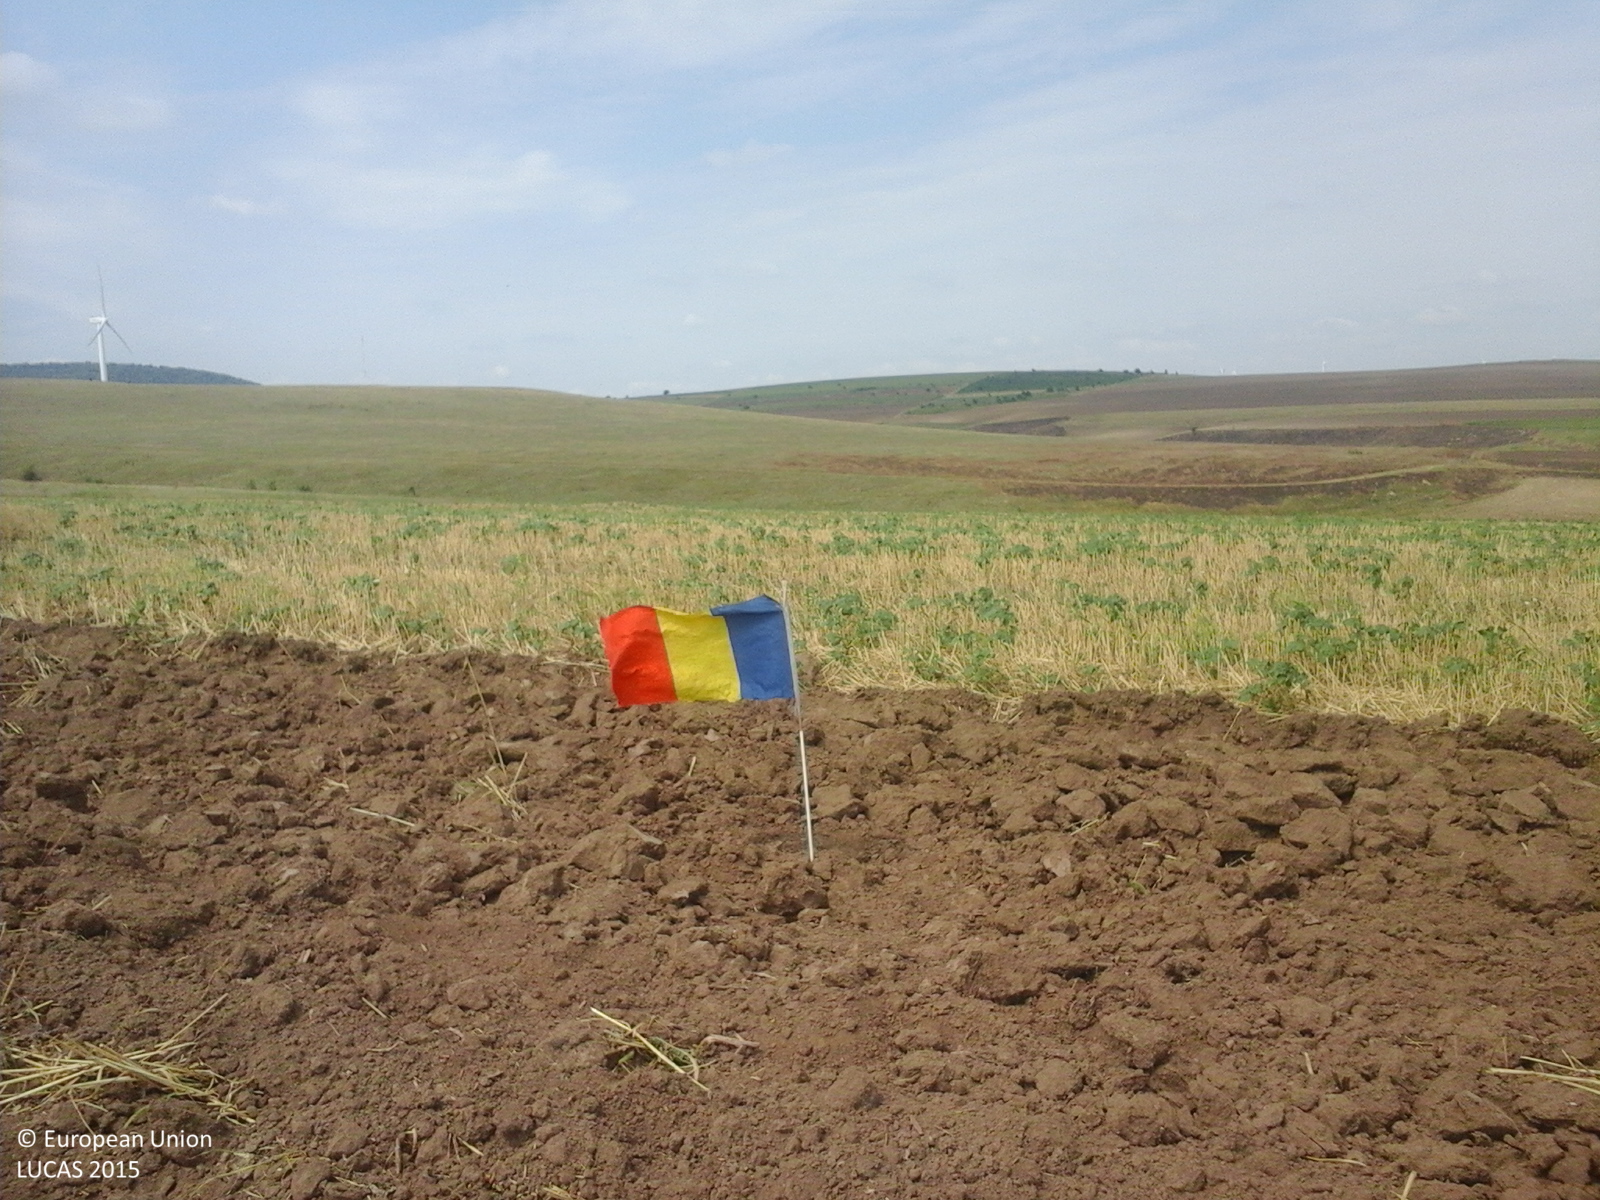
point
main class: Cropland
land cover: Common wheat
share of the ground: < 10 %
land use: Agriculture (excluding fallow land and kitchen gardens)
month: August
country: RO
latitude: 44.8929
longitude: 28.7628
